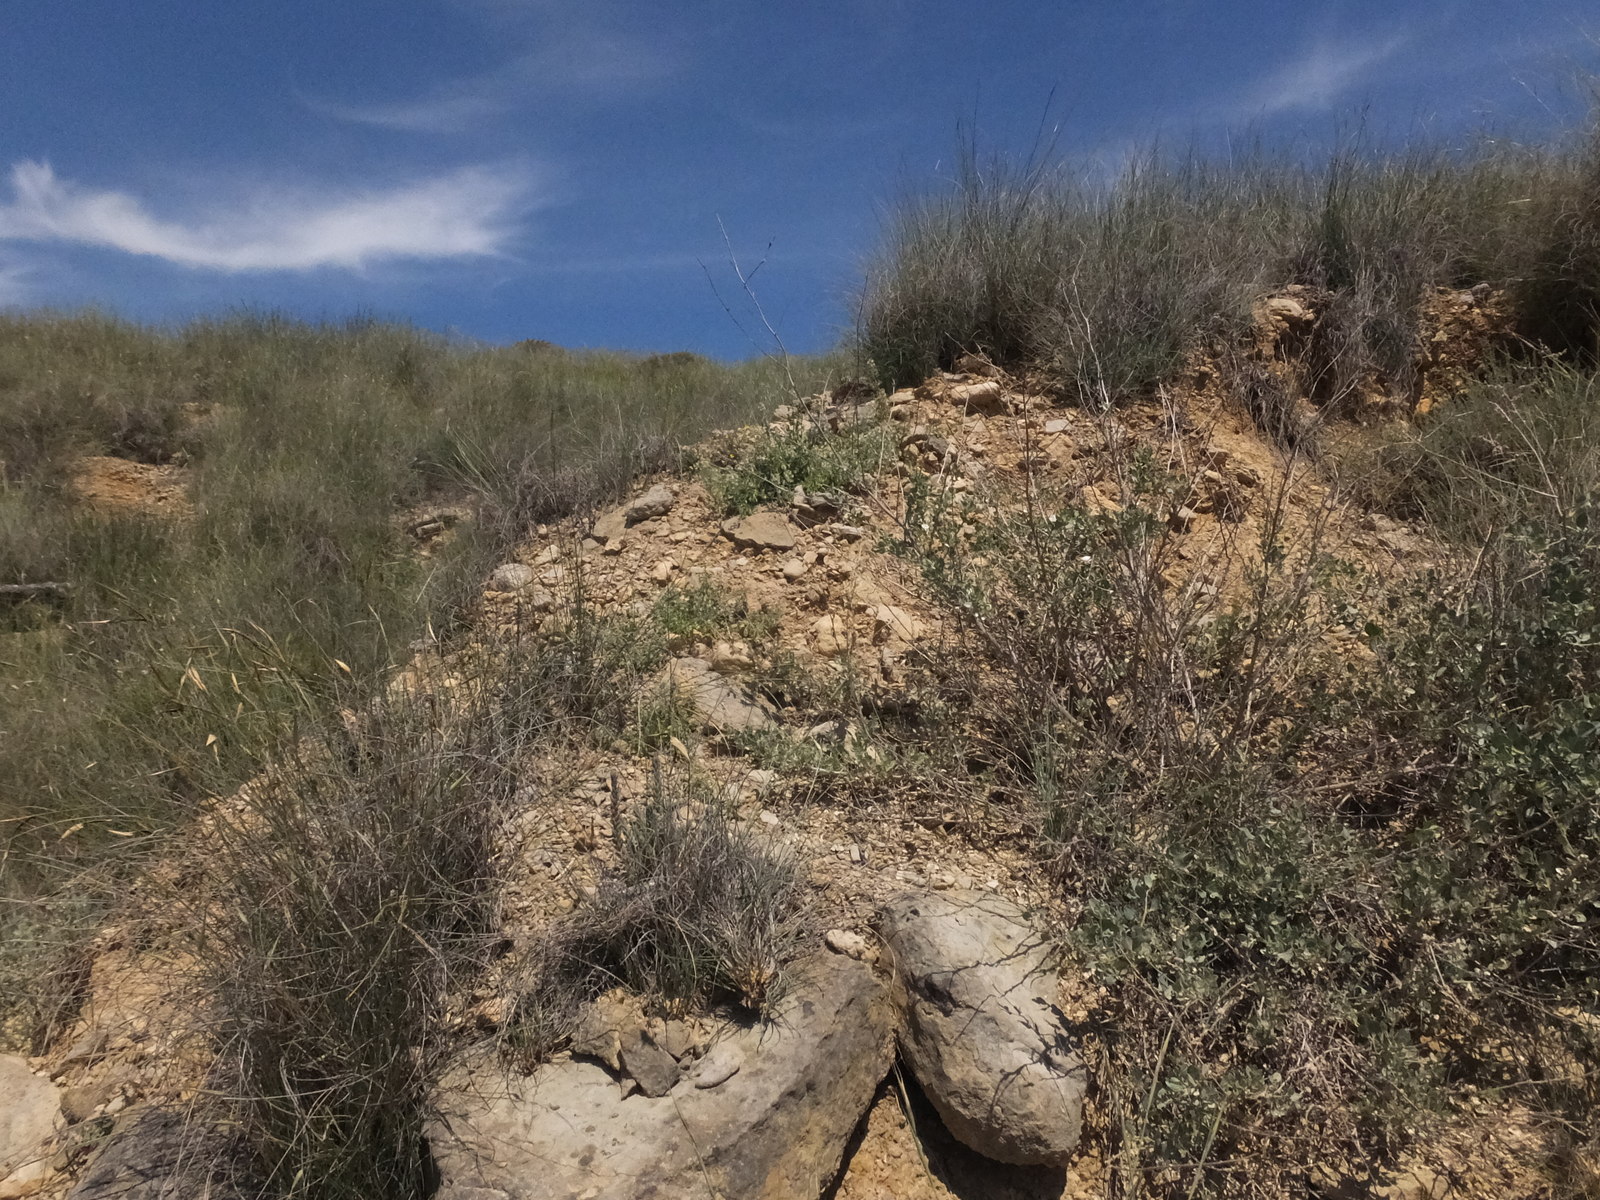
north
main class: Grassland
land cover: Grassland without tree/shrub cover
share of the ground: 50 - 75 %
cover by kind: herbaceous plants 65 %, unconsolidated bare surface 30 %, shrubs 5 %
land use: Semi-natural and natural areas not in use
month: April
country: ES
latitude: 41.7398
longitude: -0.1779
